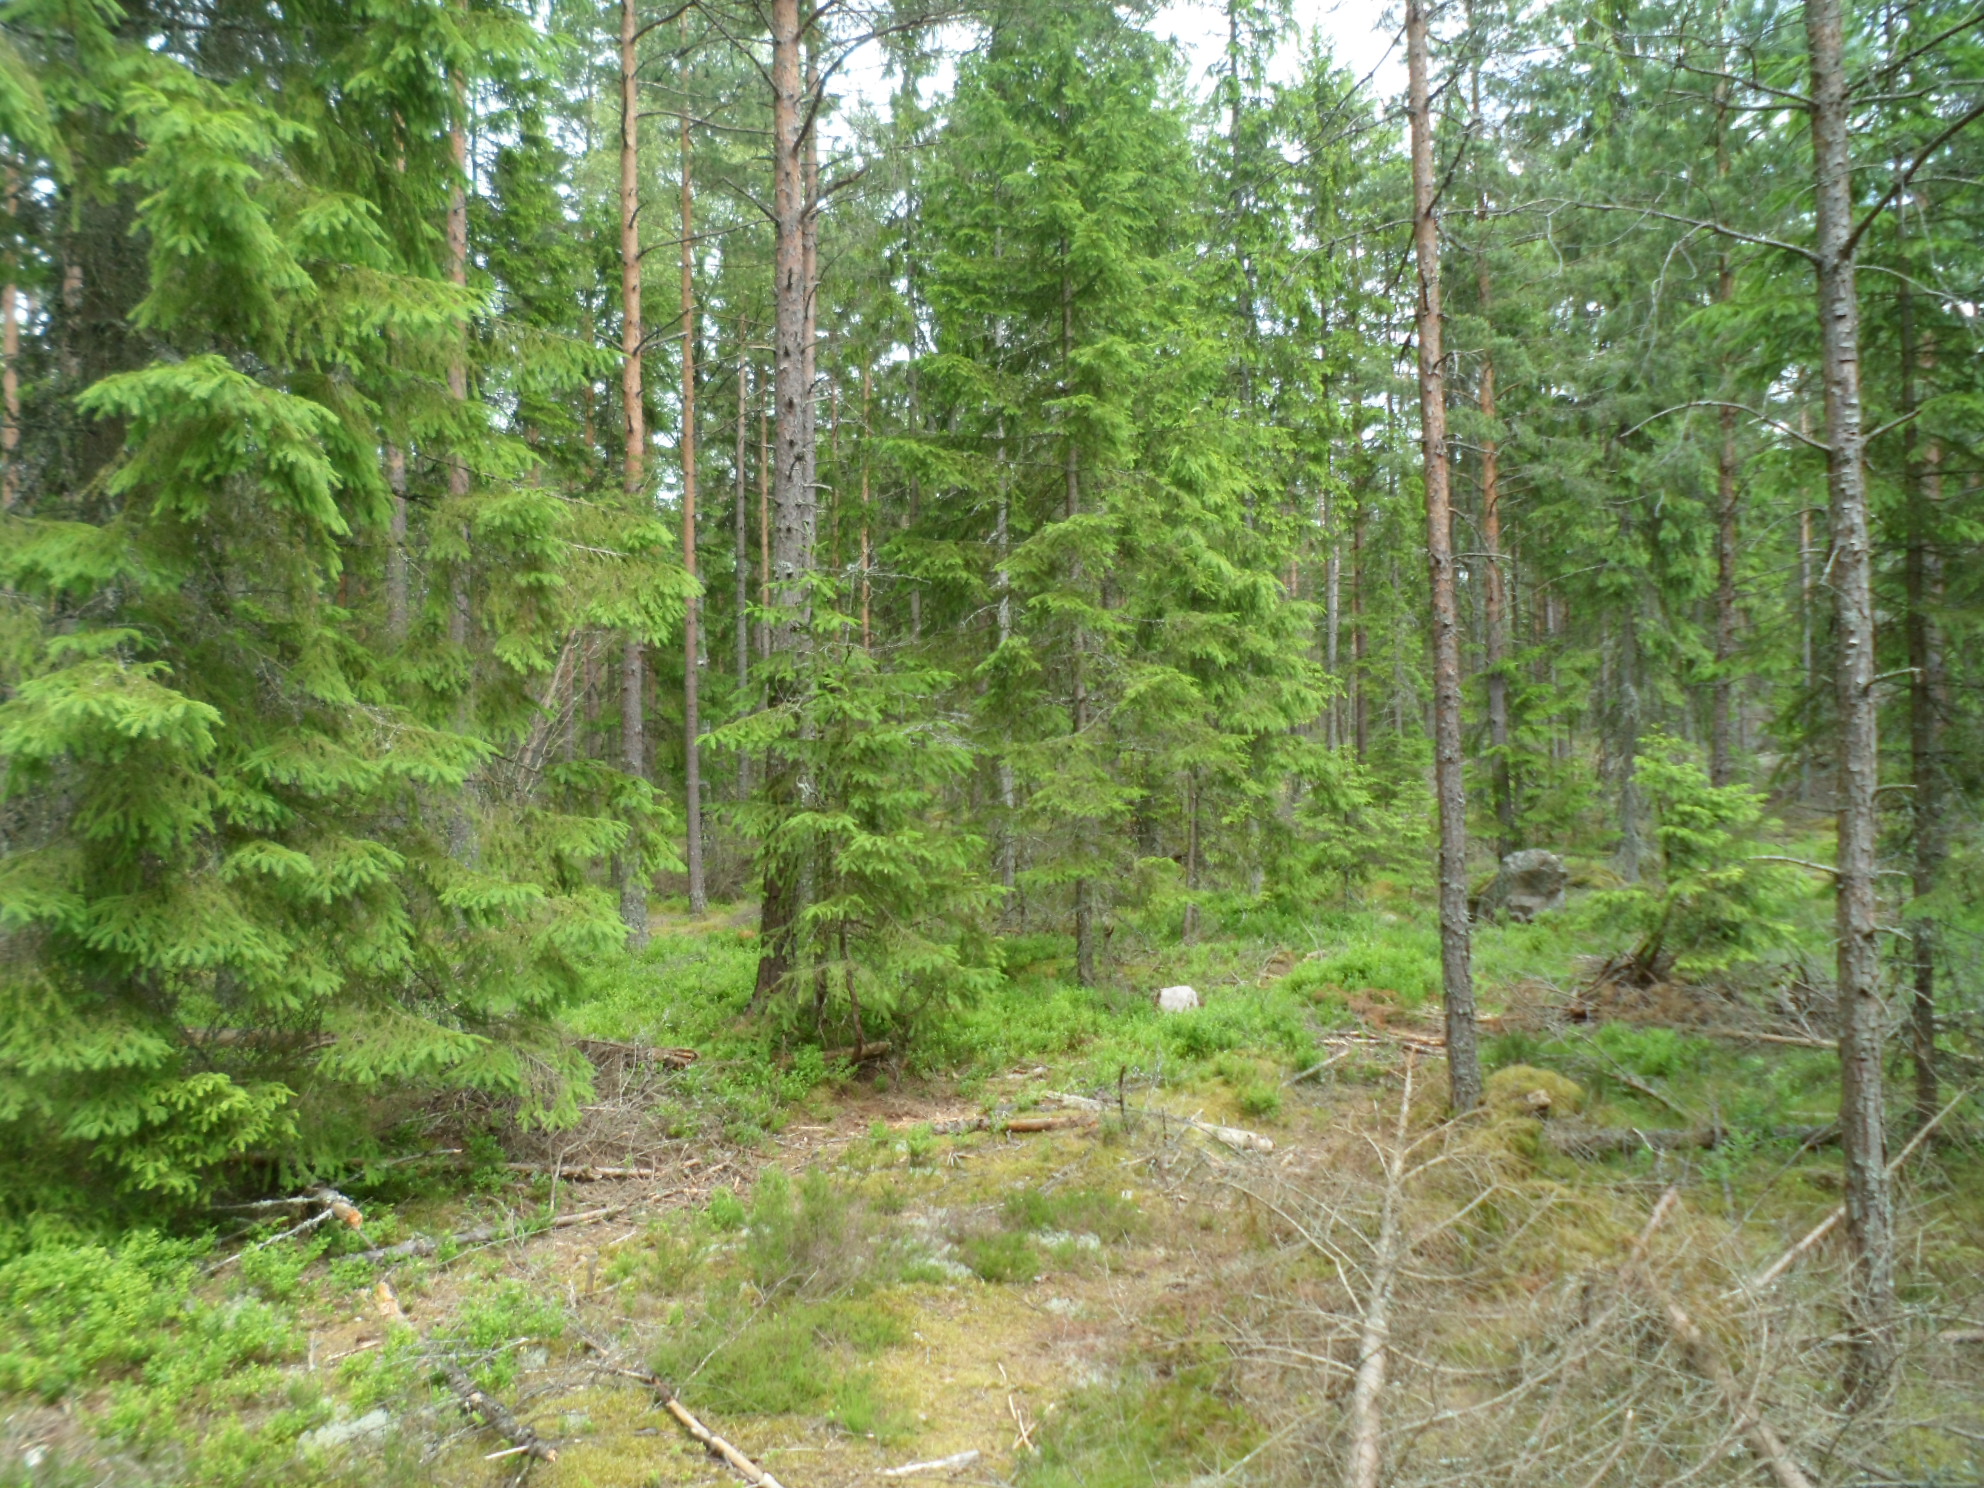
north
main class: Woodland
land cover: Pine dominated coniferous woodland
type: boreal forest
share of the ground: 50 - 75 %
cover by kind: coniferous forest trees 50 %, shrubs 20 %, lichens and mosses 20 %, herbaceous plants 10 %
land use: Forestry
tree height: > 5 m
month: June
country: SE
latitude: 56.9623
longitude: 15.2768
